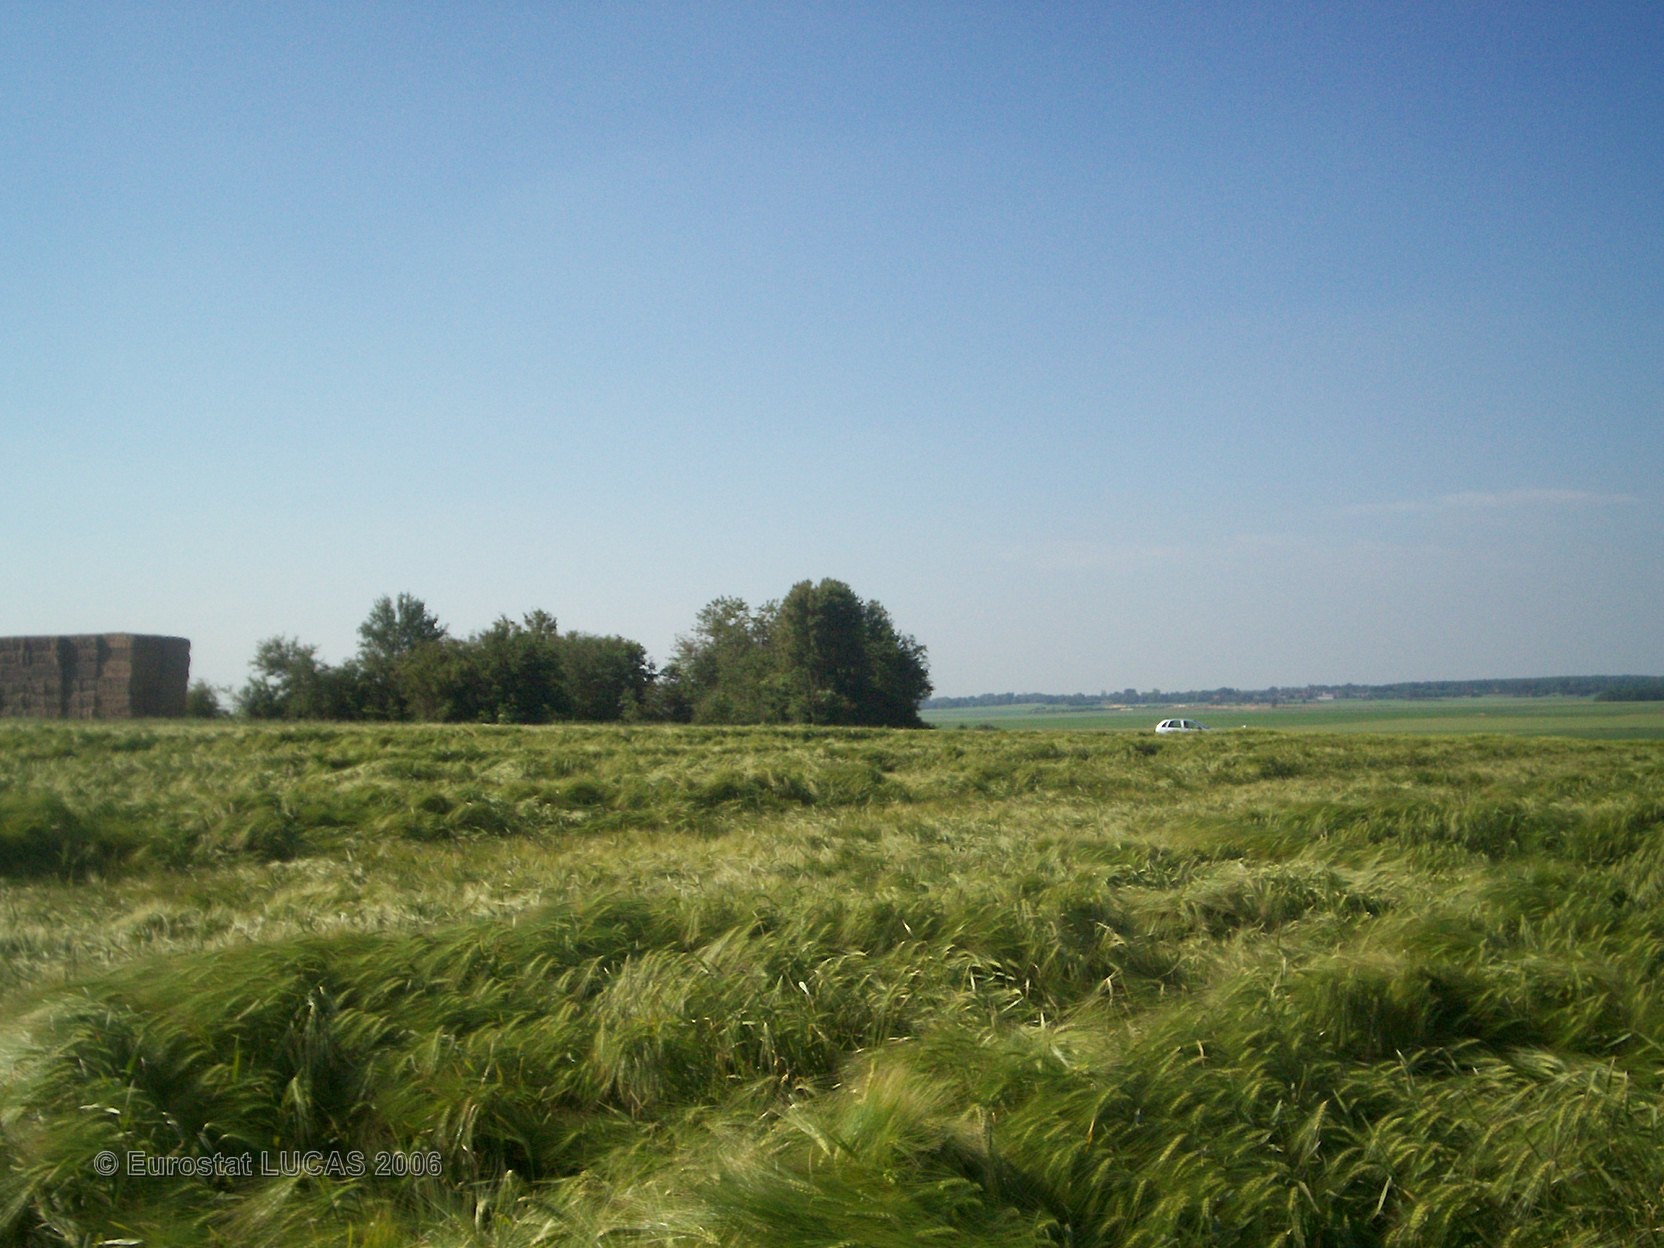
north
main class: Cropland
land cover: Barley
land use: Agriculture (excluding fallow land and kitchen gardens)
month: June
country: FR
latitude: 49.5495
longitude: 2.6493
